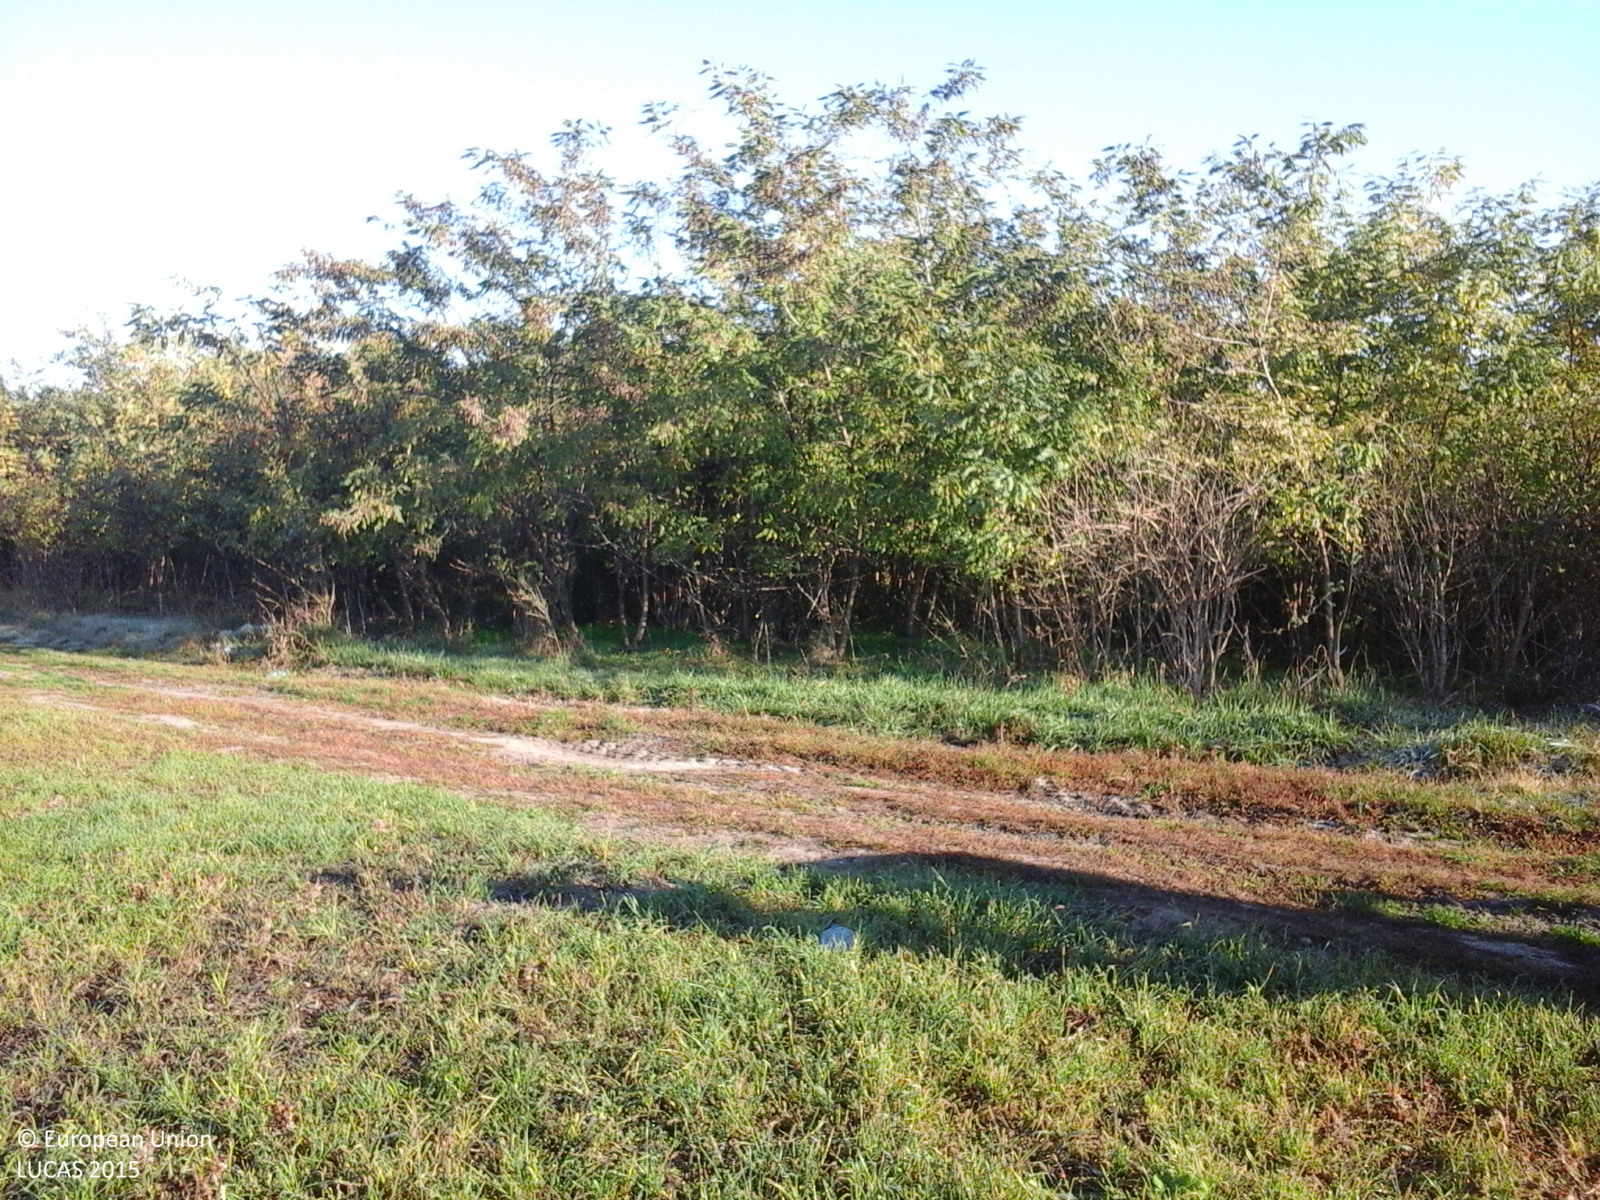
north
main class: Grassland
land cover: Grassland without tree/shrub cover
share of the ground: > 75 %
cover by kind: herbaceous plants 100 %
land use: Agriculture (excluding fallow land and kitchen gardens)
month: October
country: RO
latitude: 45.6348
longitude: 27.1419
